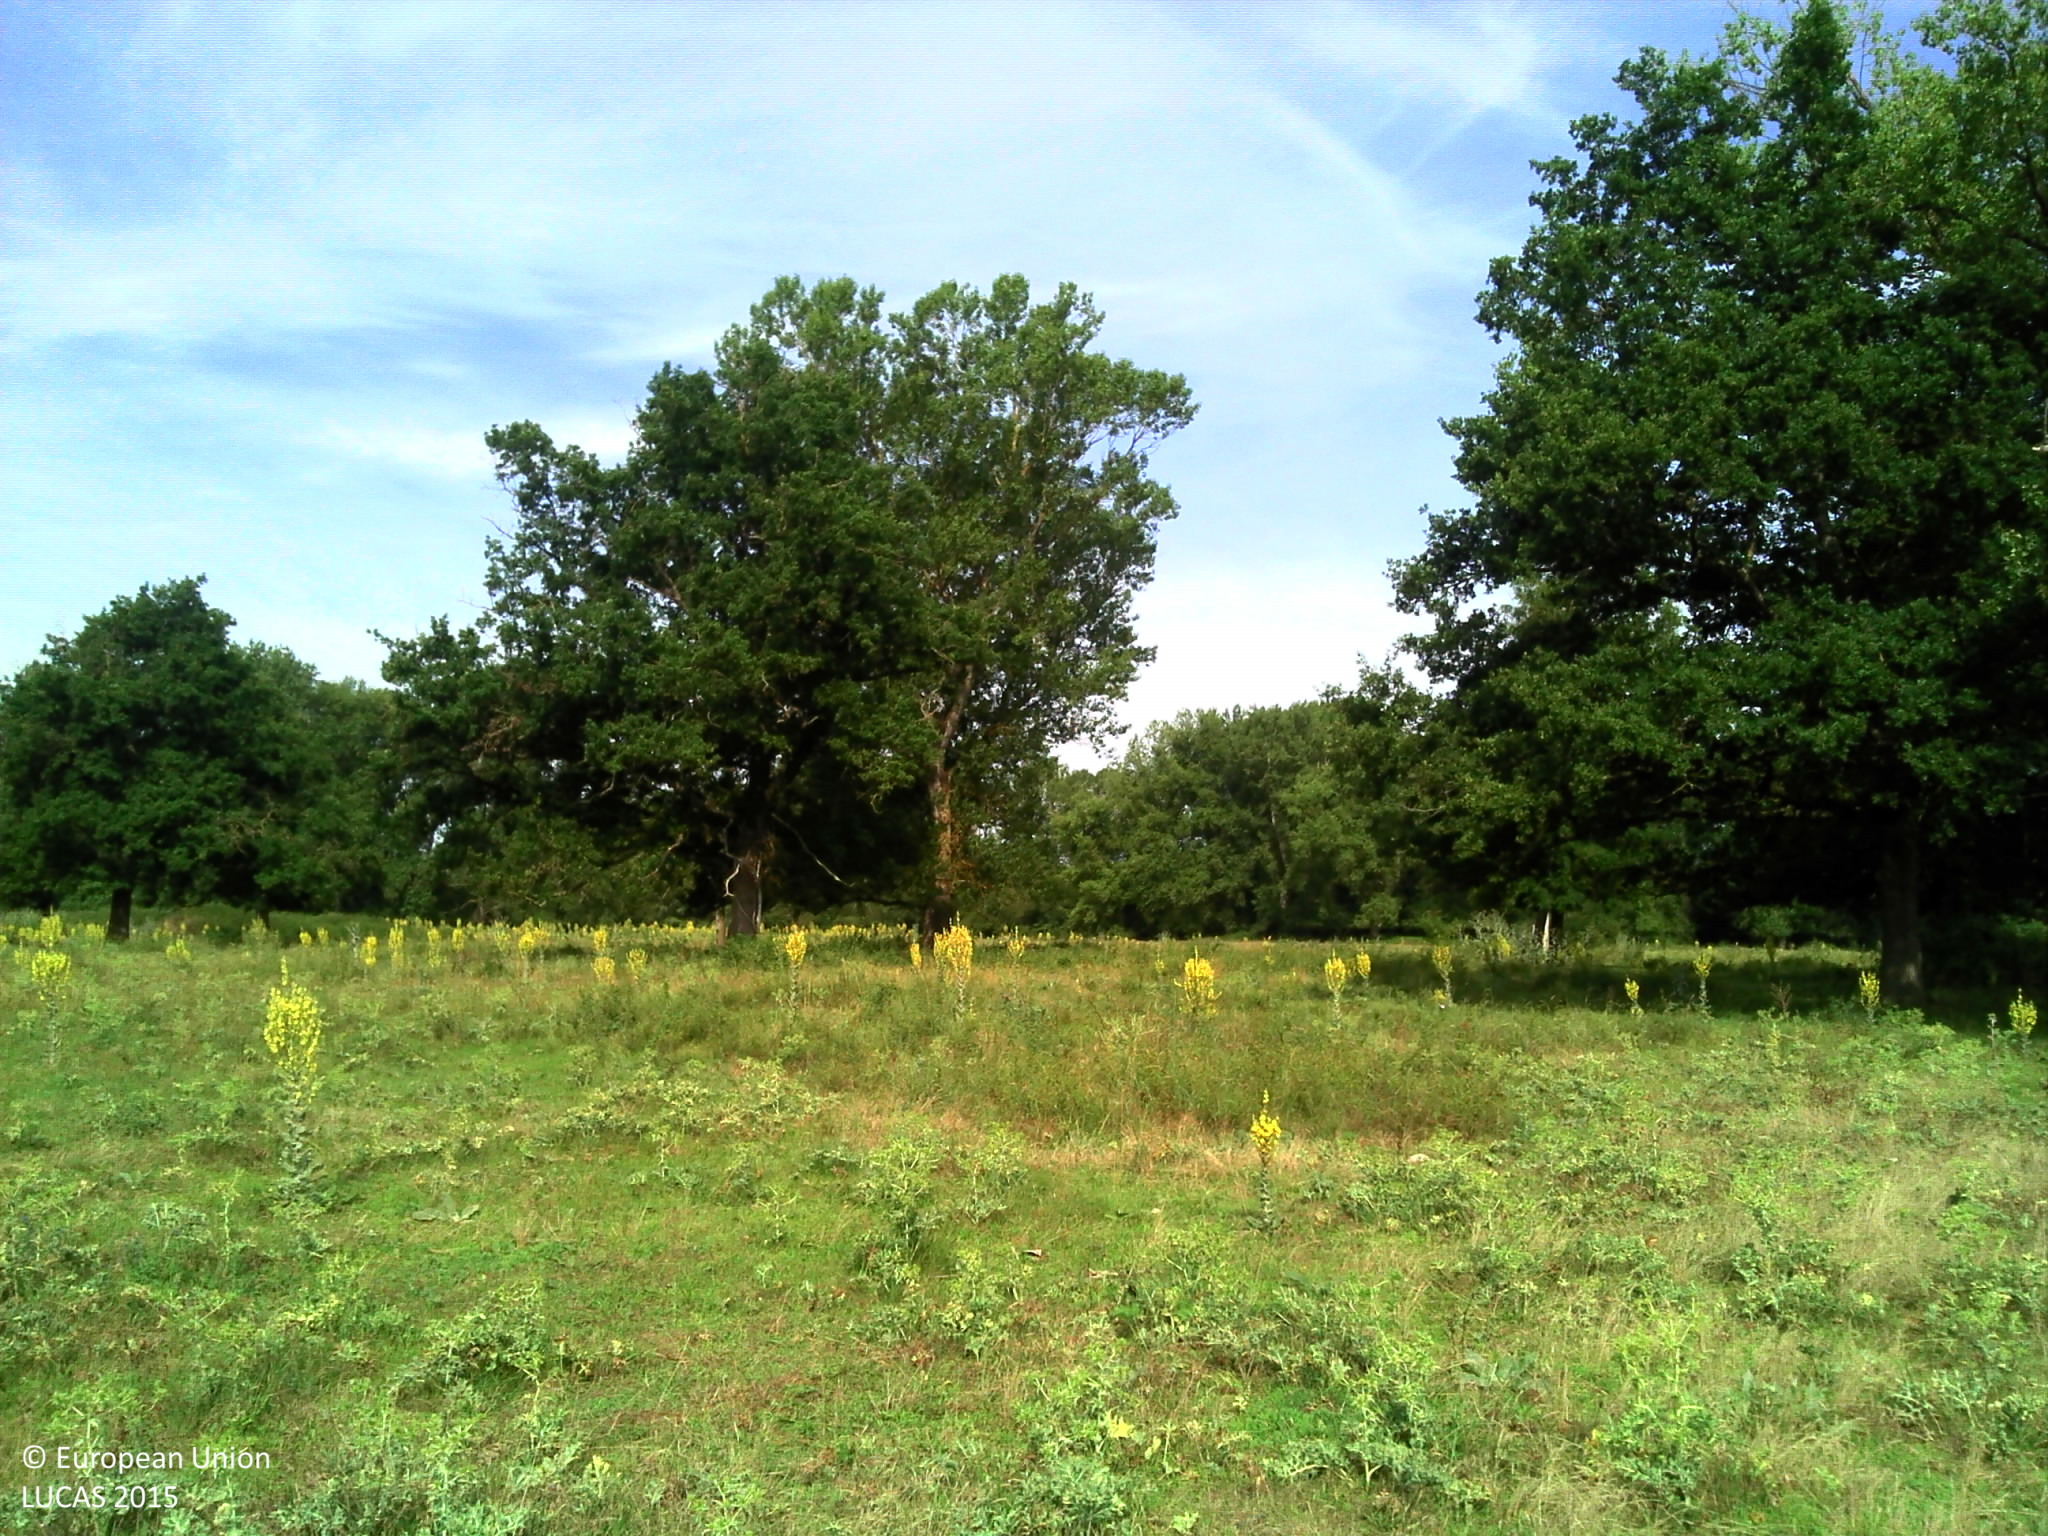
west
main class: Grassland
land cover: Grassland without tree/shrub cover
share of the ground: > 75 %
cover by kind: herbaceous plants 95 %, shrubs 5 %
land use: Agriculture (excluding fallow land and kitchen gardens)
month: June
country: FR
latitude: 46.3599
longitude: 3.3313
